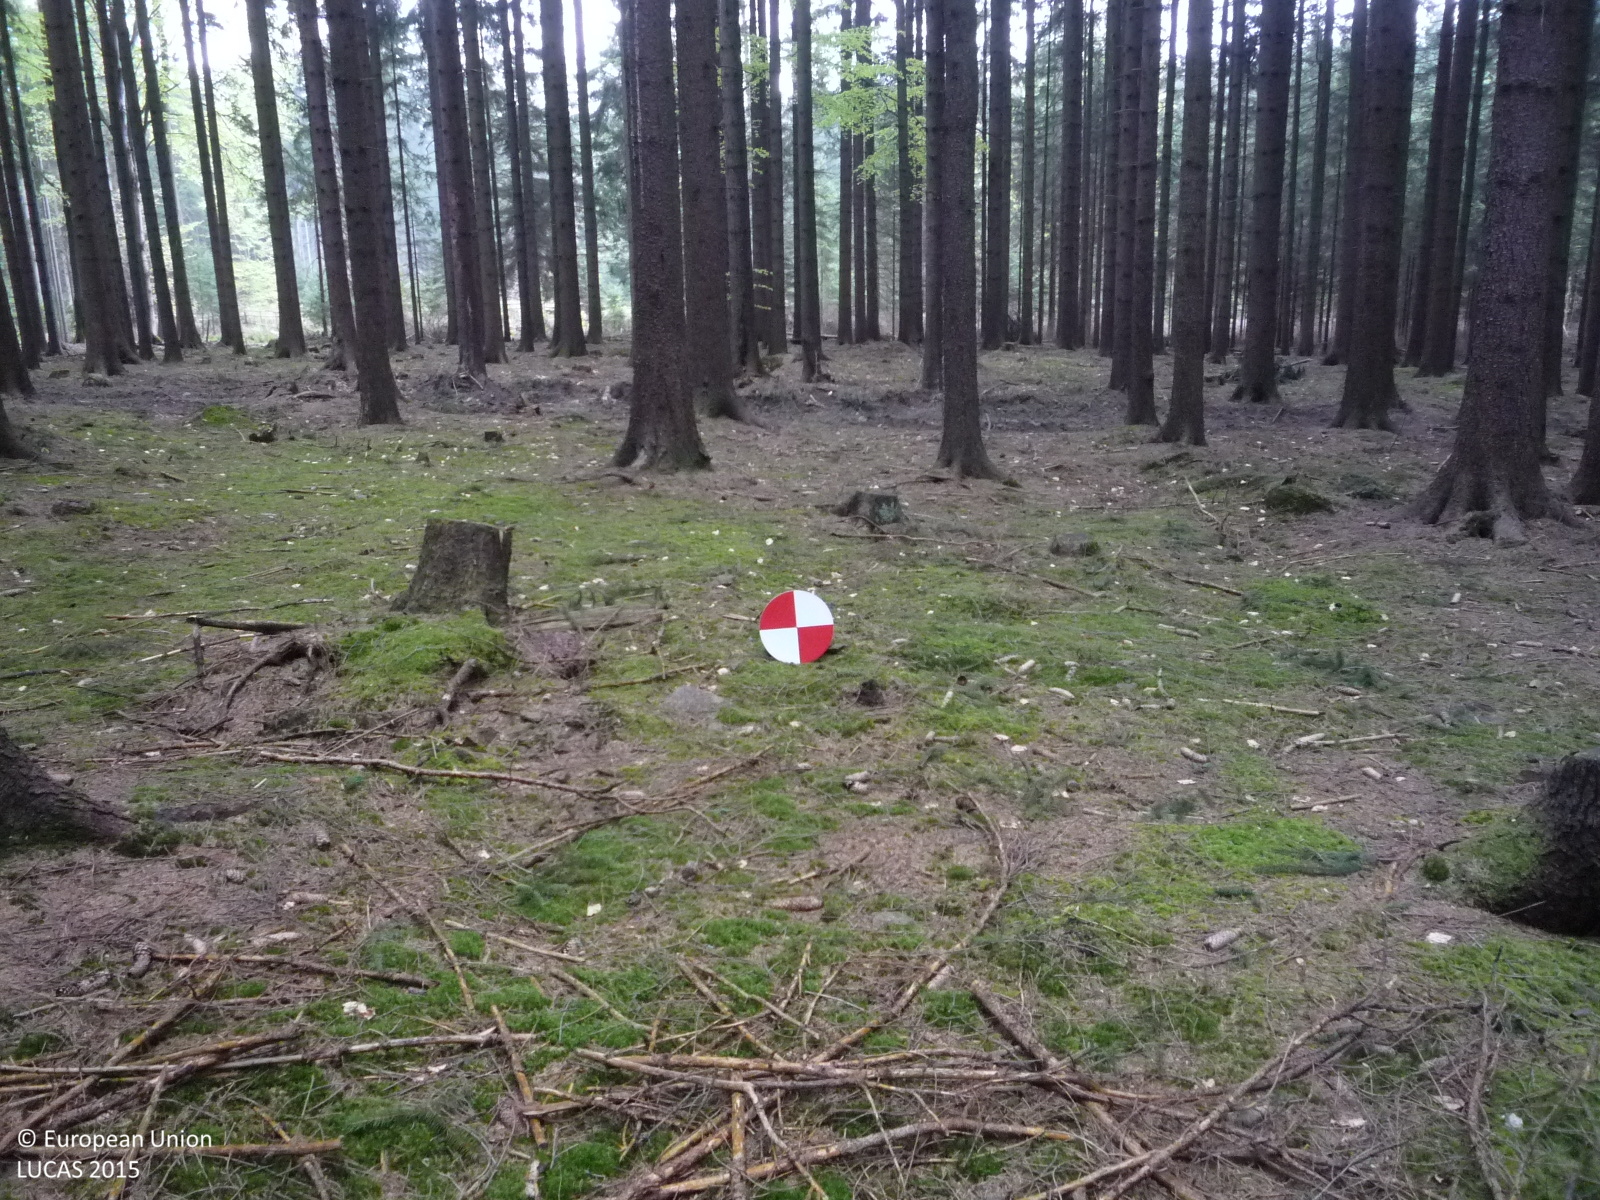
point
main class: Woodland
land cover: Spruce dominated coniferous woodland
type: hemiboreal forest and nemoral coniferous forest and mixed broadleaved-coniferous forest
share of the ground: > 75 %
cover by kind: coniferous forest trees 90 %, lichens and mosses 10 %
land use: Forestry
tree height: > 5 m
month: April
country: CZ
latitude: 49.3294
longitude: 15.5215
